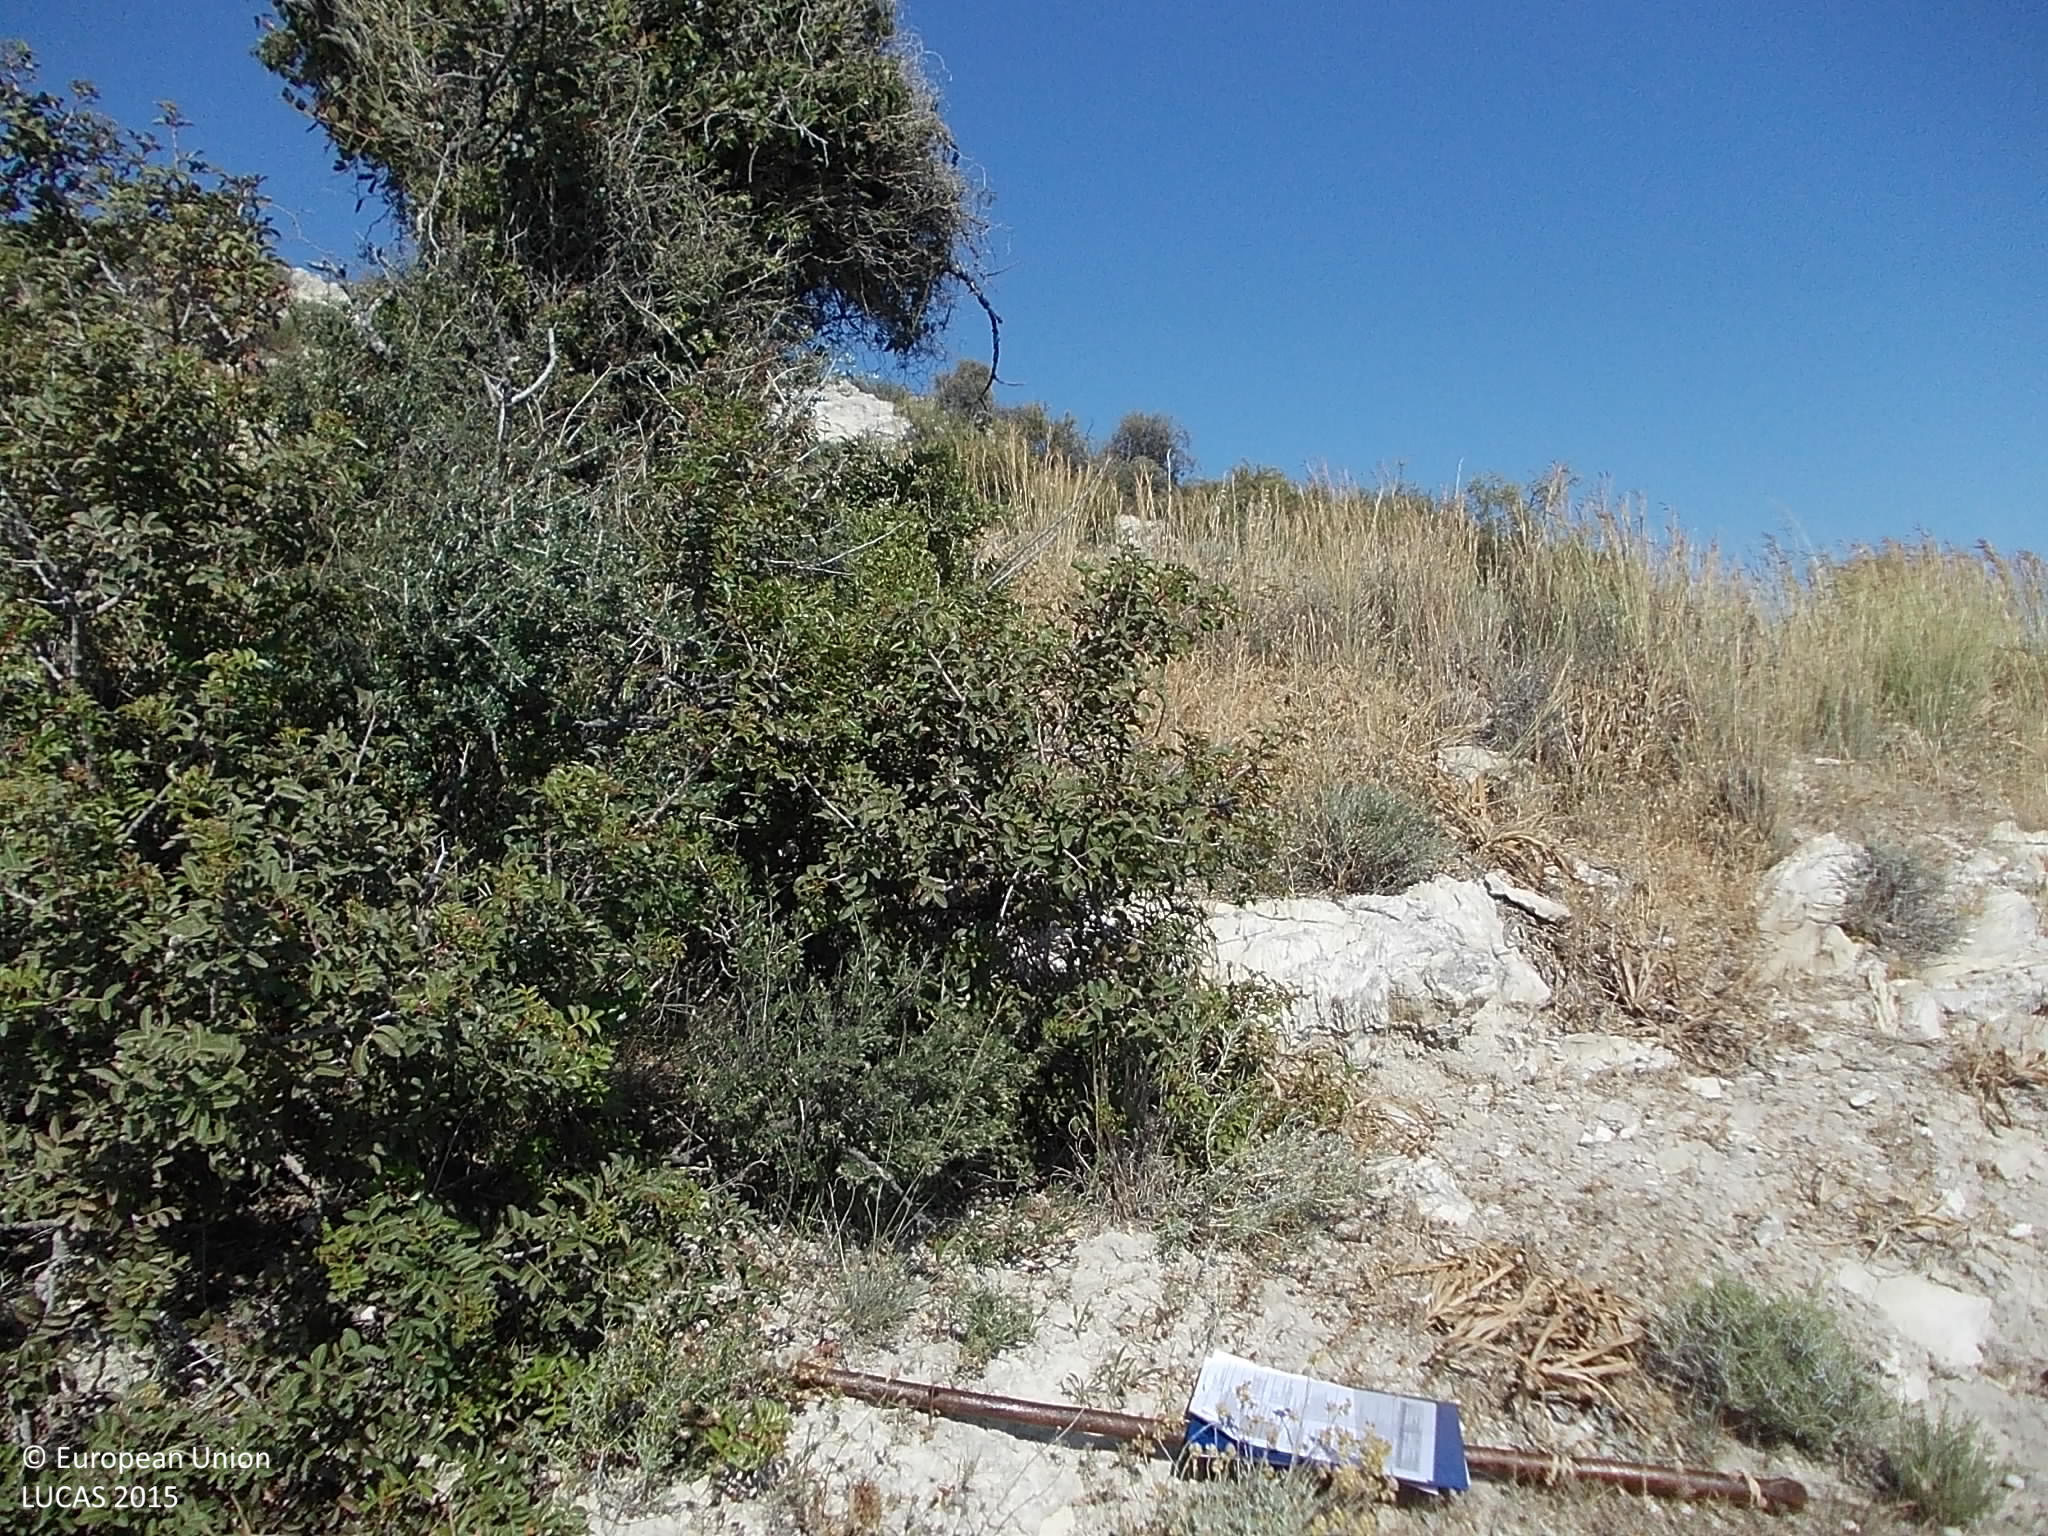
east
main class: Shrubland
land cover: Shrubland without tree cover
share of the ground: 25 - 50 %
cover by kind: shrubs 40 %, herbaceous plants 30 %, consolidated bare surface 30 %
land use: Semi-natural and natural areas not in use
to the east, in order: Shrubland without tree cover; Shrubland with sparse tree cover; Shrubland without tree cover; Tracks; Shrubland with sparse tree cover; Shrubland without tree cover; Tracks; Shrubland without tree cover; Shrubland with sparse tree cover
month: May
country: CY
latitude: 34.6797
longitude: 32.7122
